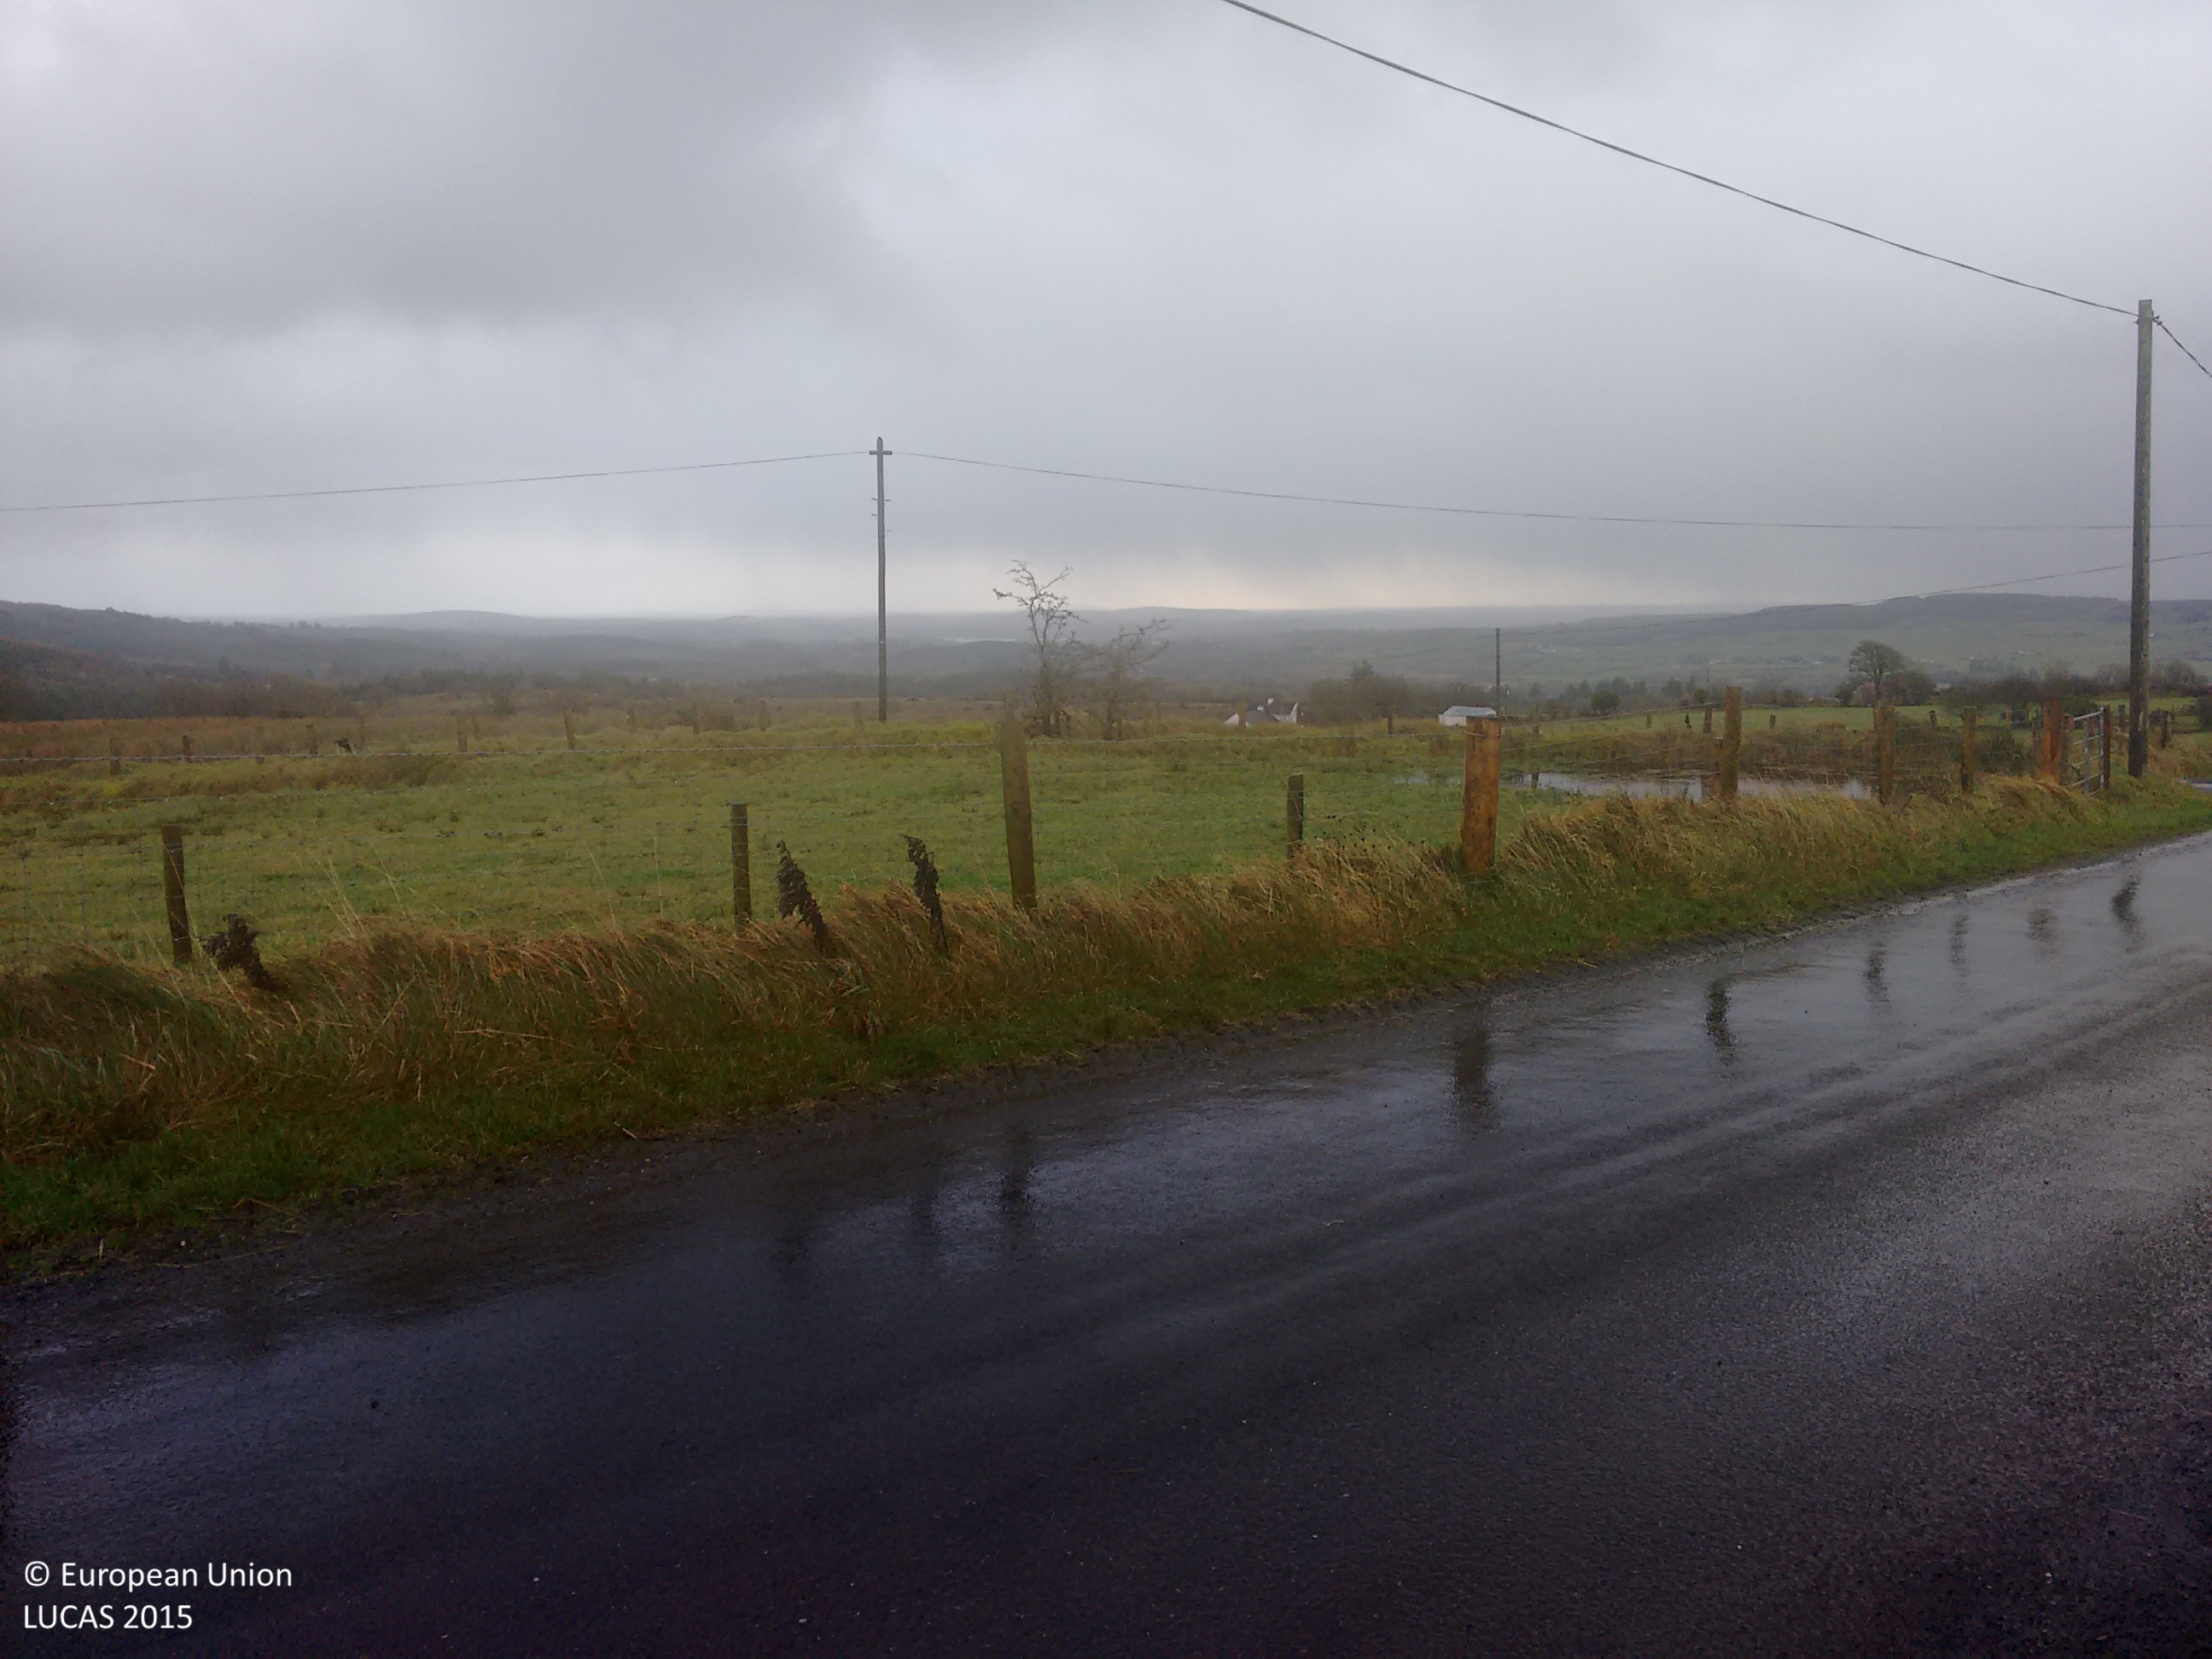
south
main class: Grassland
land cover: Grassland without tree/shrub cover
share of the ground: > 75 %
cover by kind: herbaceous plants 100 %
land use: Agriculture (excluding fallow land and kitchen gardens)
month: November
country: IE
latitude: 54.1212
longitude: -8.2525
